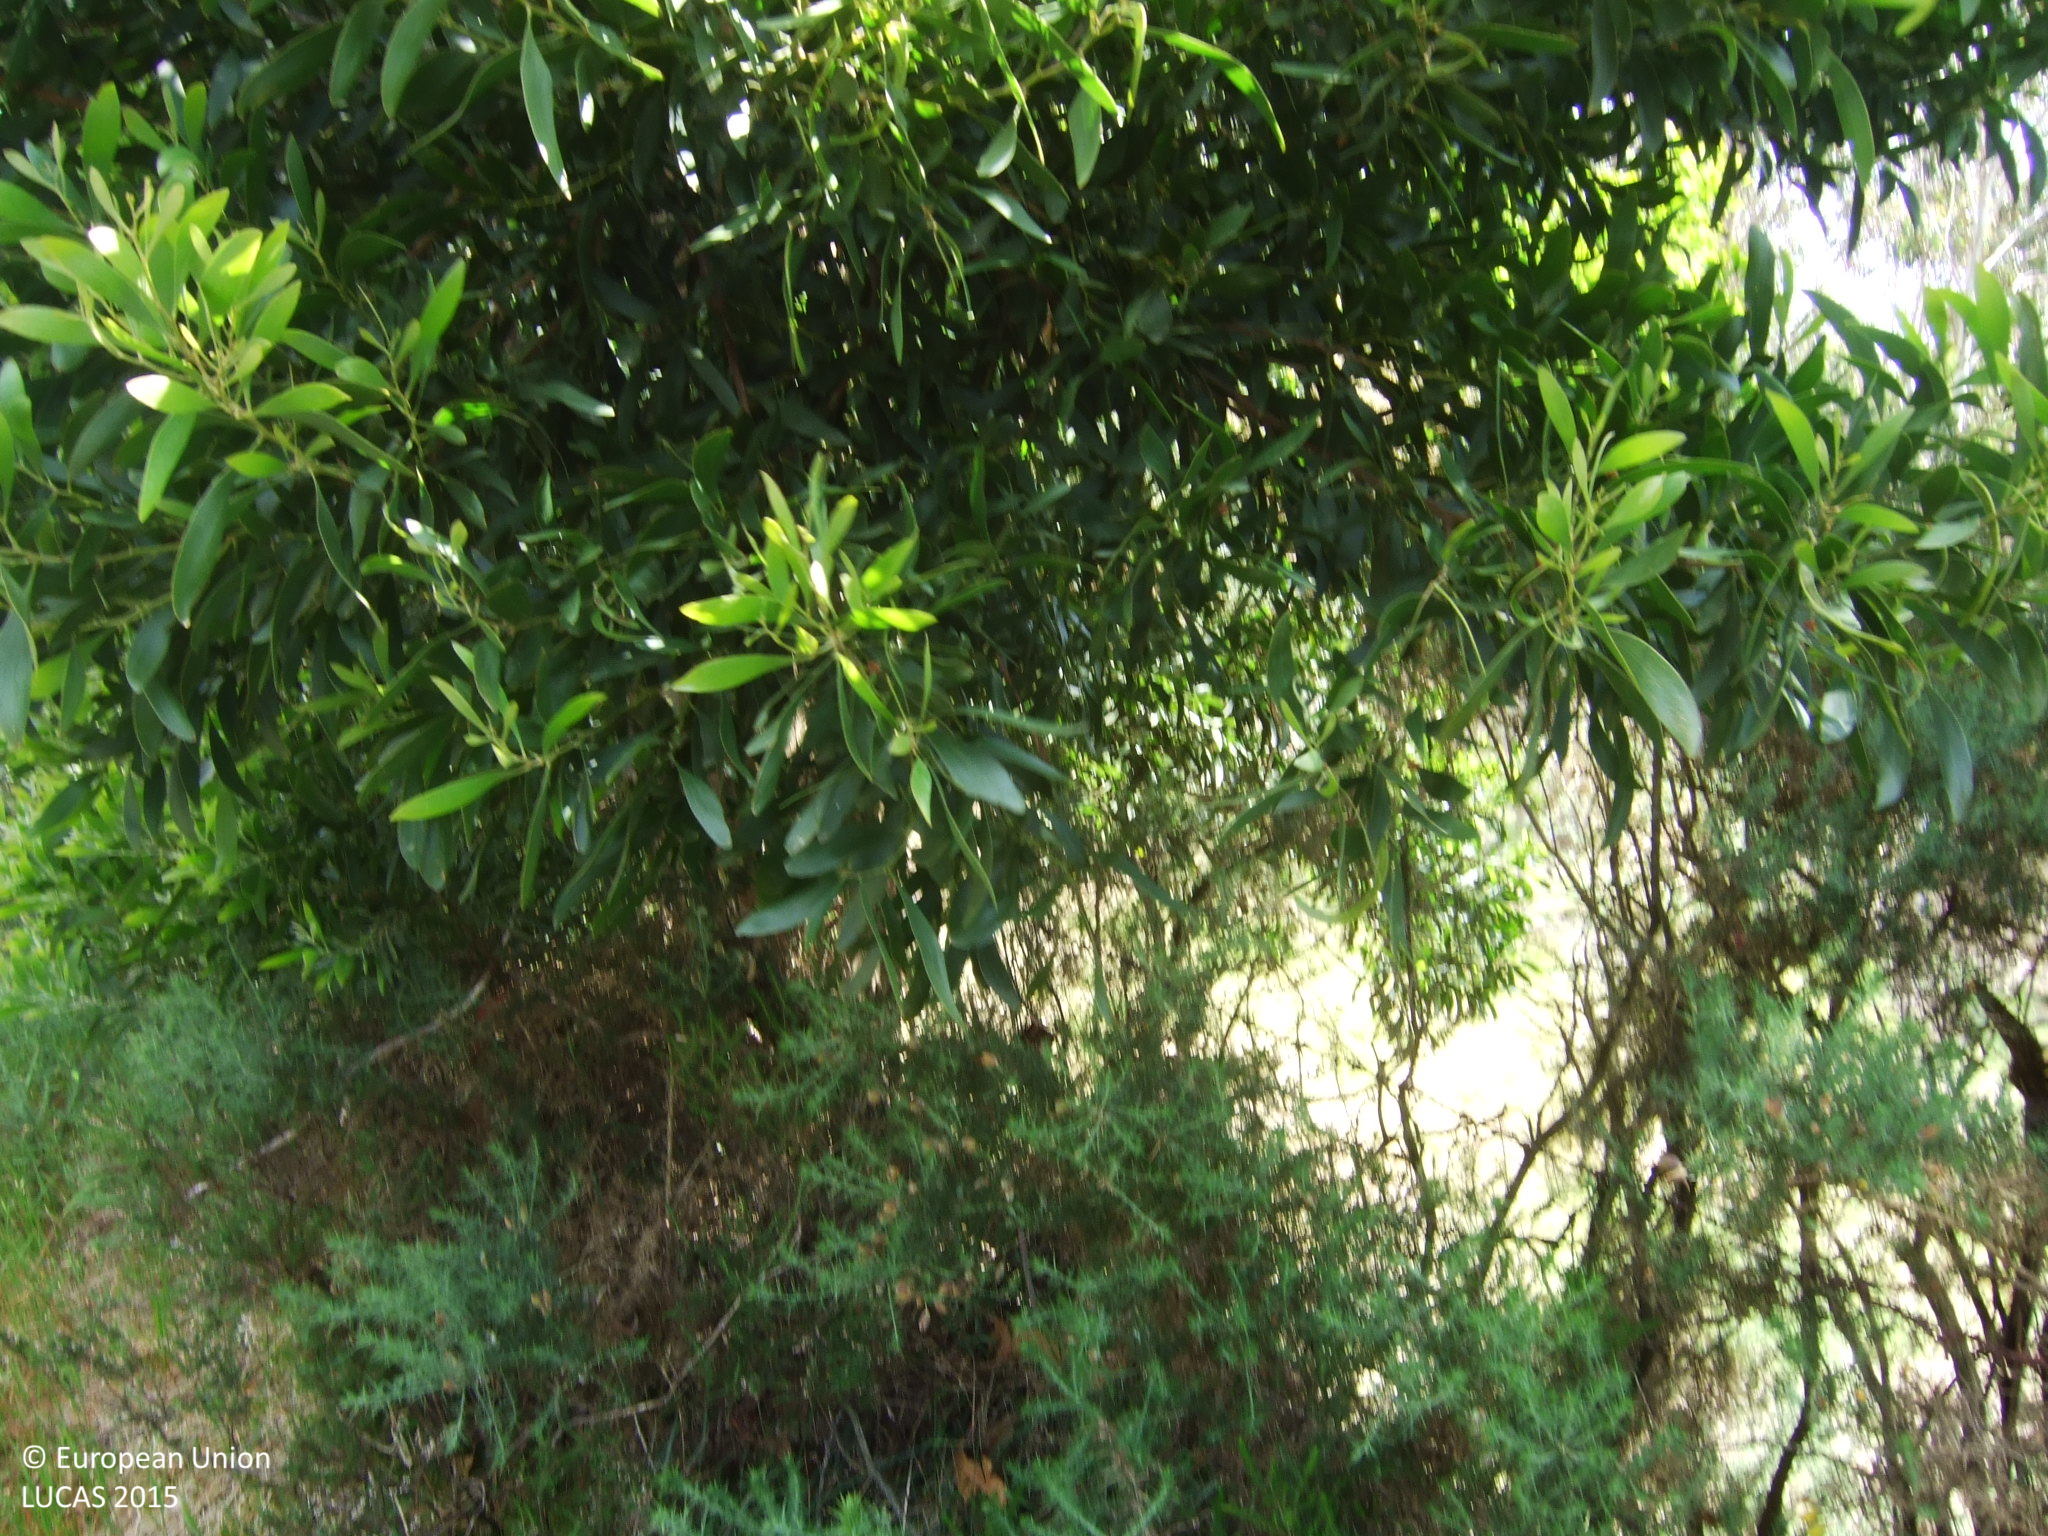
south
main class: Shrubland
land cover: Shrubland without tree cover
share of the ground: > 75 %
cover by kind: shrubs 100 %
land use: Semi-natural and natural areas not in use
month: June
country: ES
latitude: 43.4774
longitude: -7.8061
